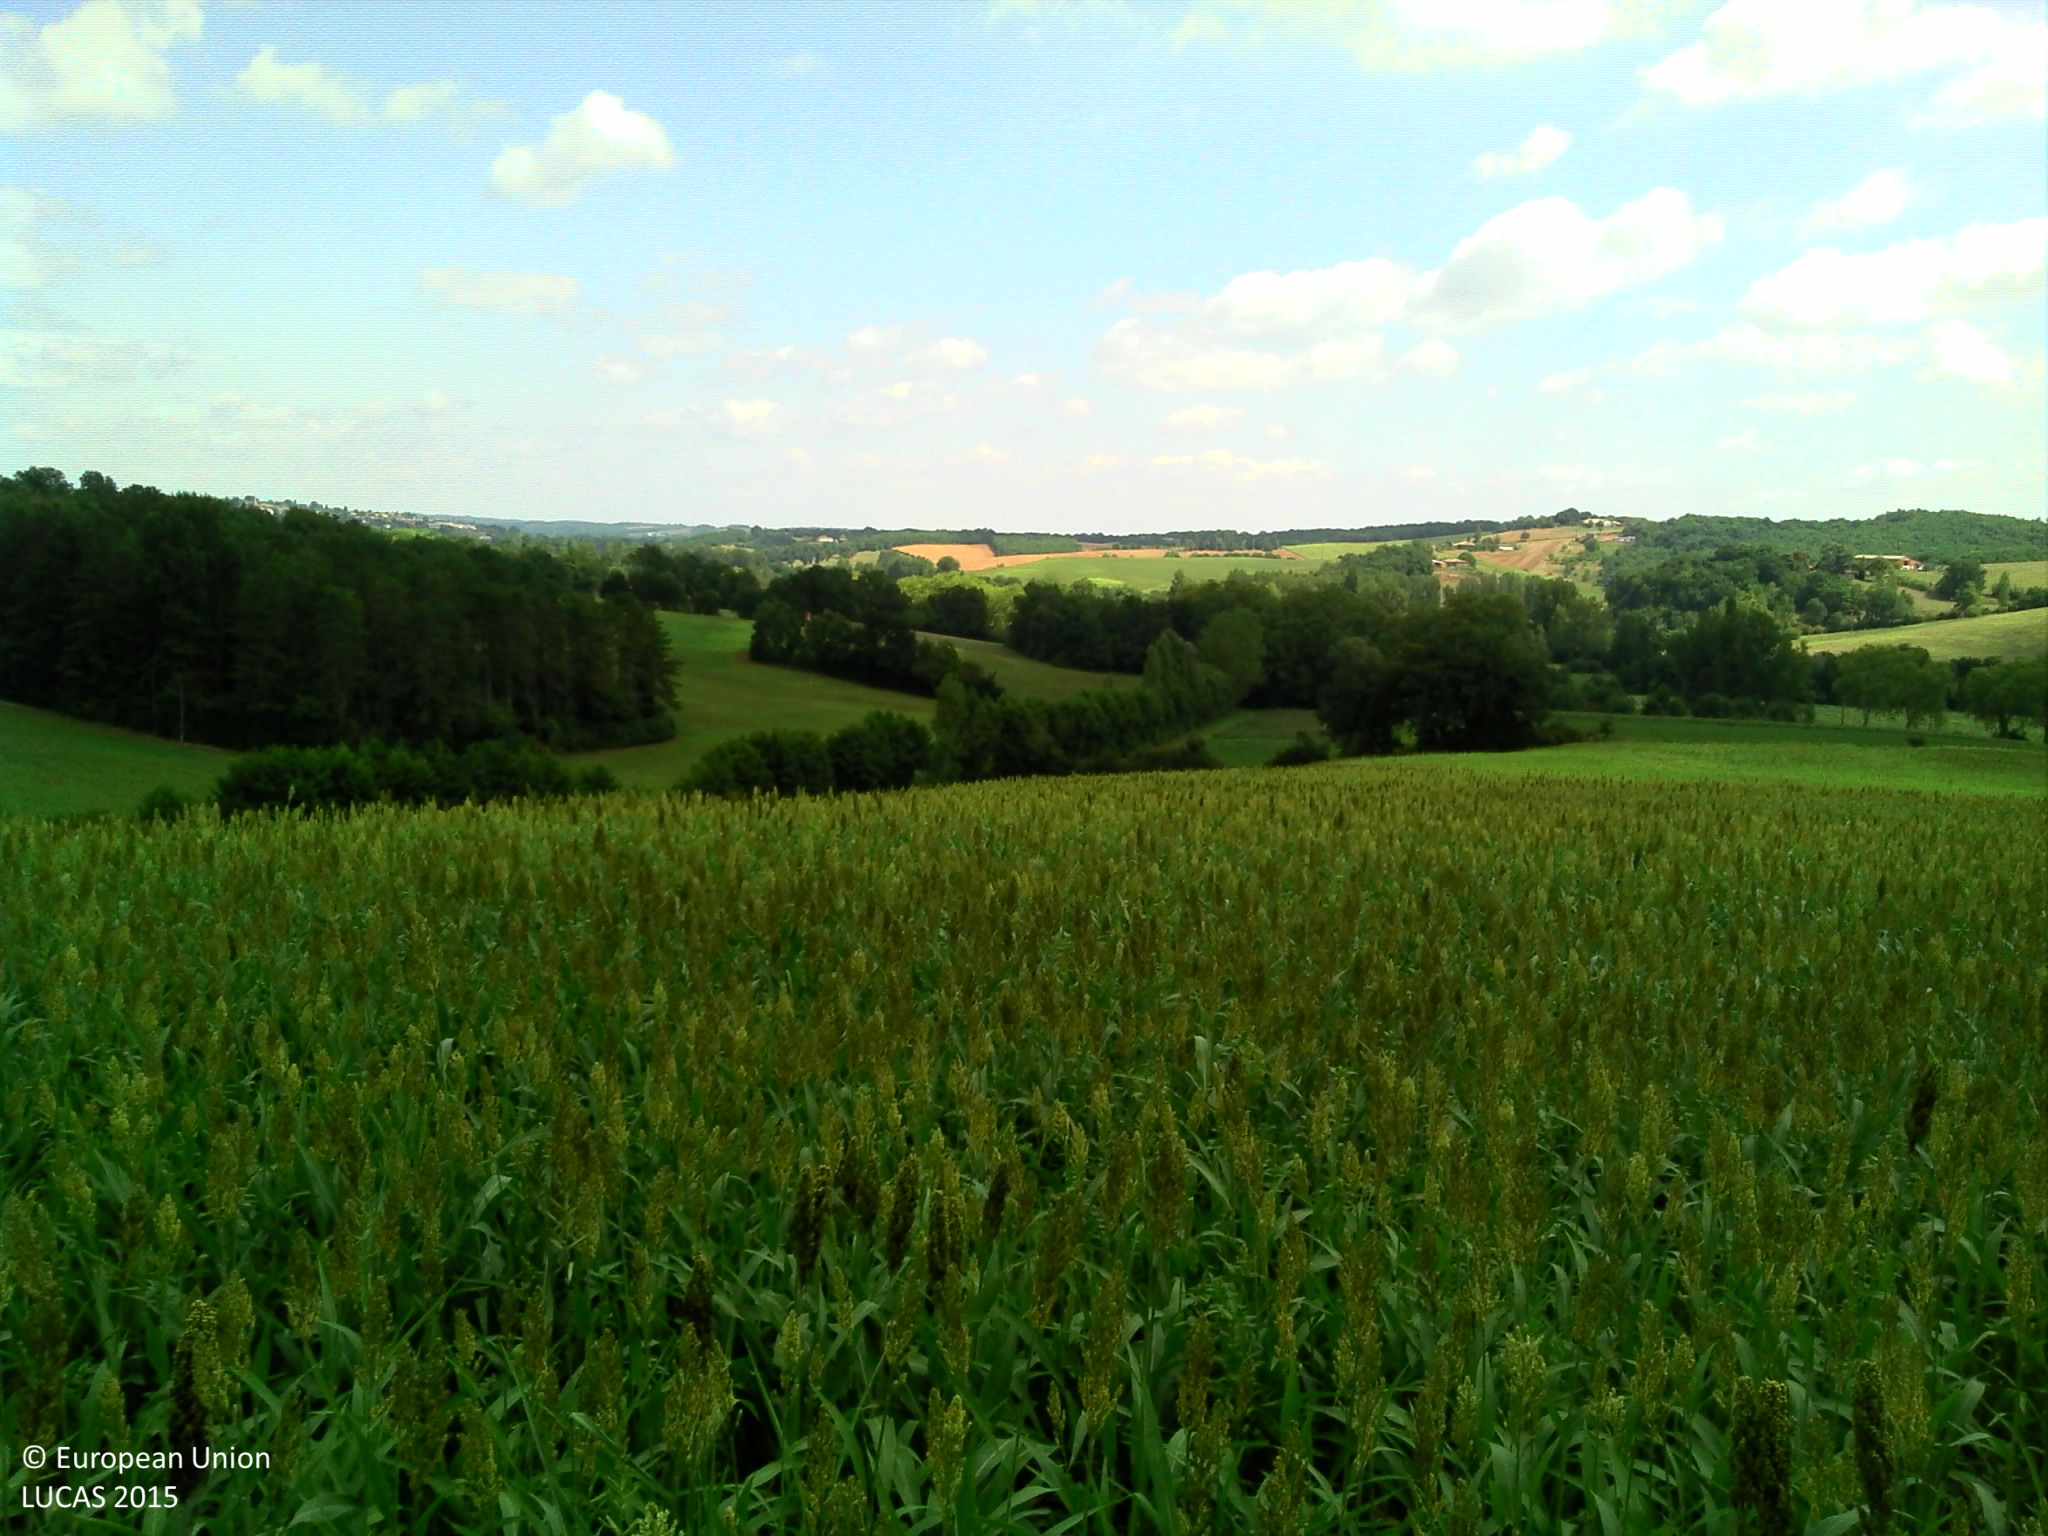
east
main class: Grassland
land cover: Grassland with sparse tree/shrub cover
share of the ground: > 75 %
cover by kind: herbaceous plants 95 %, broadleaved forest trees 5 %
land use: Residential
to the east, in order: Grassland with sparse tree/shrub cover; Other cereals; Grassland without tree/shrub cover; Managed hedges; Rivers and streams; Grassland without tree/shrub cover; Other cereals
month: August
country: FR
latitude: 43.9682
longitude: 1.5379
